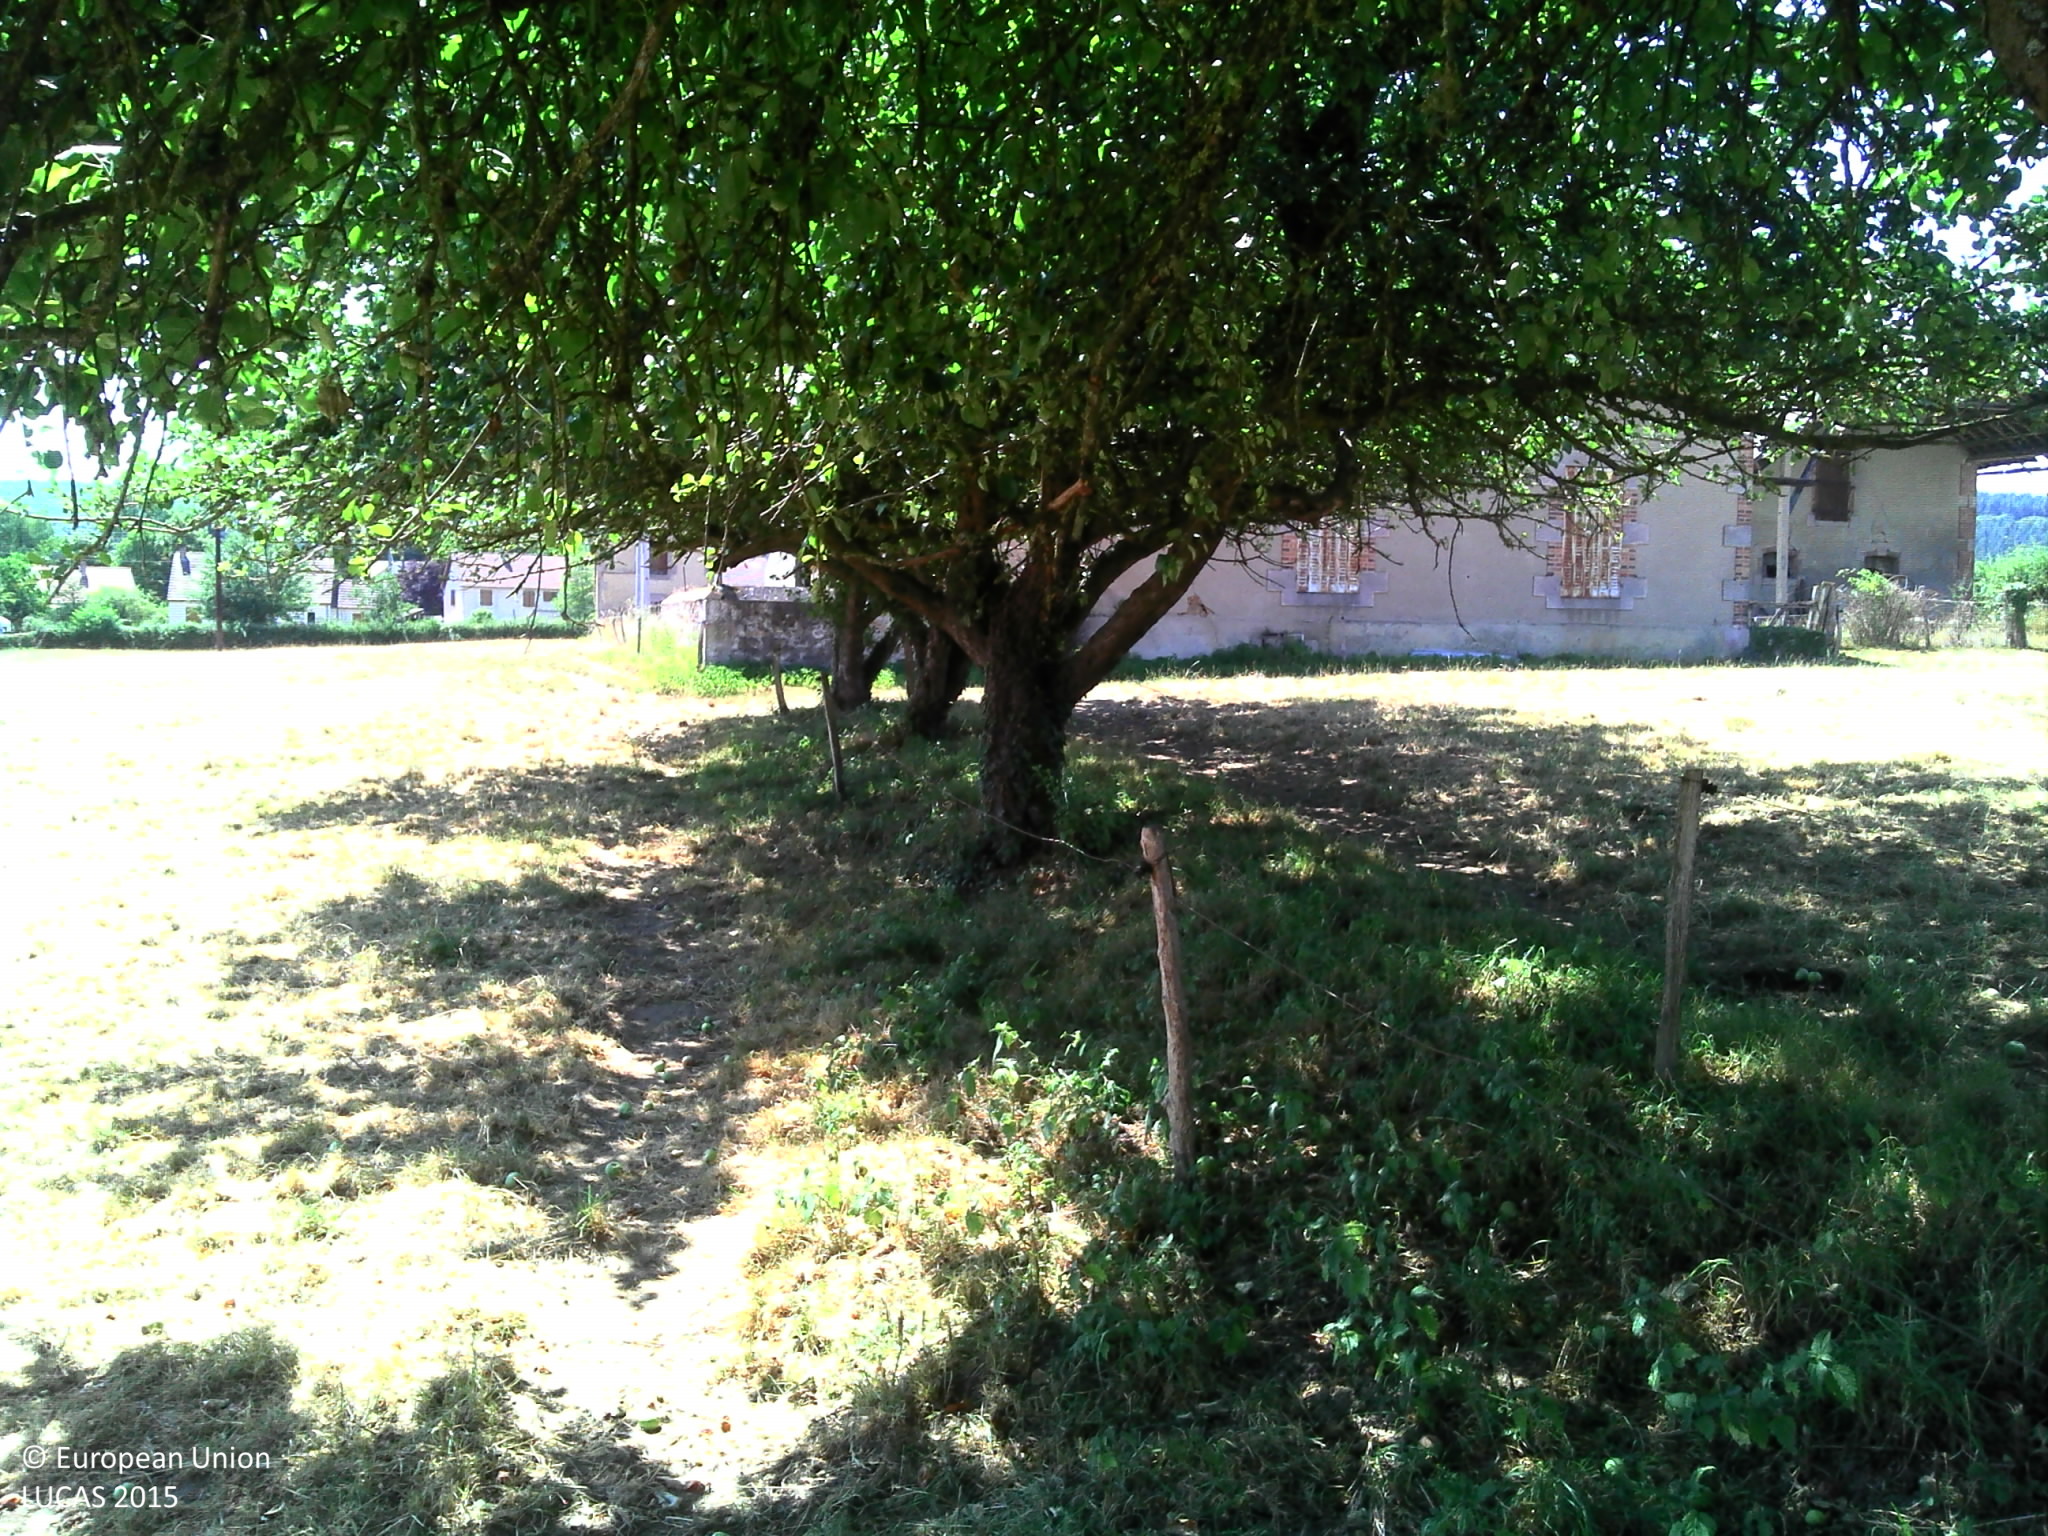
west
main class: Cropland
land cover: Apple fruit
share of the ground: 50 - 75 %
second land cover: Grassland without tree/shrub cover
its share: 25 - 50 %
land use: Agriculture (excluding fallow land and kitchen gardens)
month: July
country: FR
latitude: 46.7945
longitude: 3.9598
